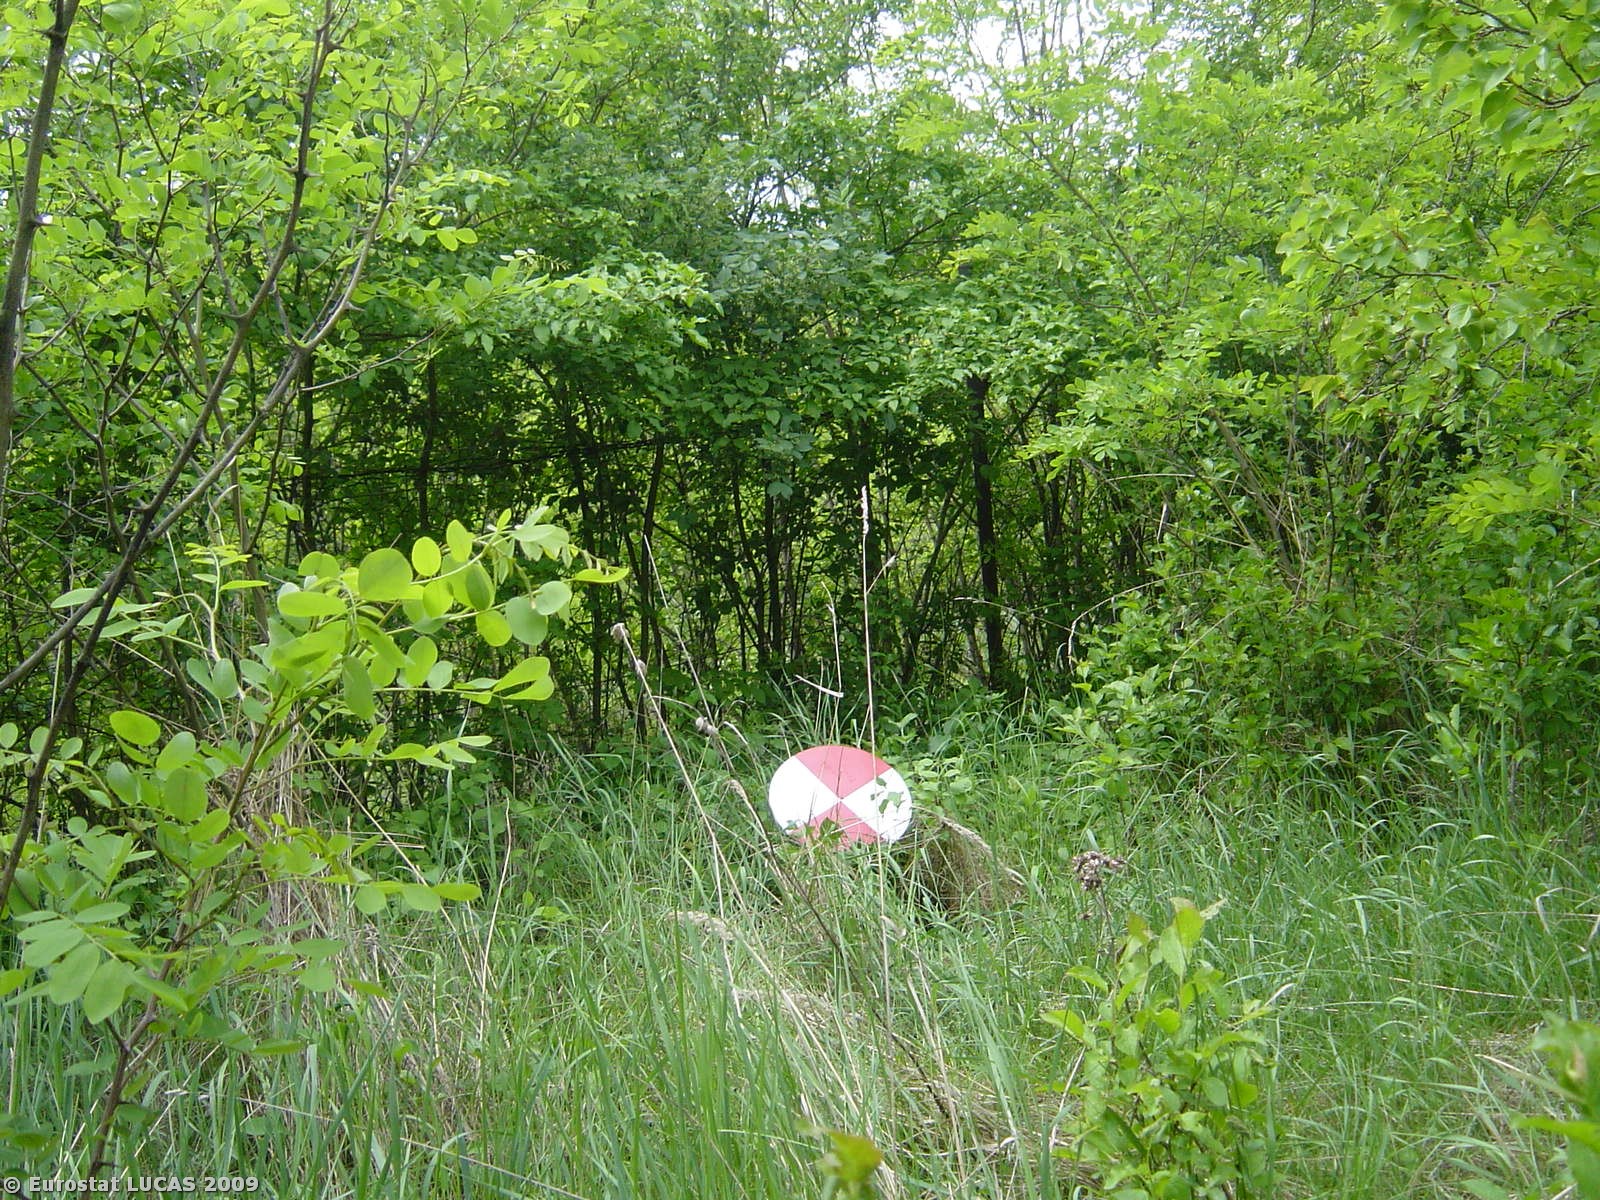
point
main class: Woodland
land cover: Broadleaved woodland
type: floodplain forest
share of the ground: > 75 %
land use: Unused
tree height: > 5 m
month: May
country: CZ
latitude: 49.0827
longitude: 16.4279
